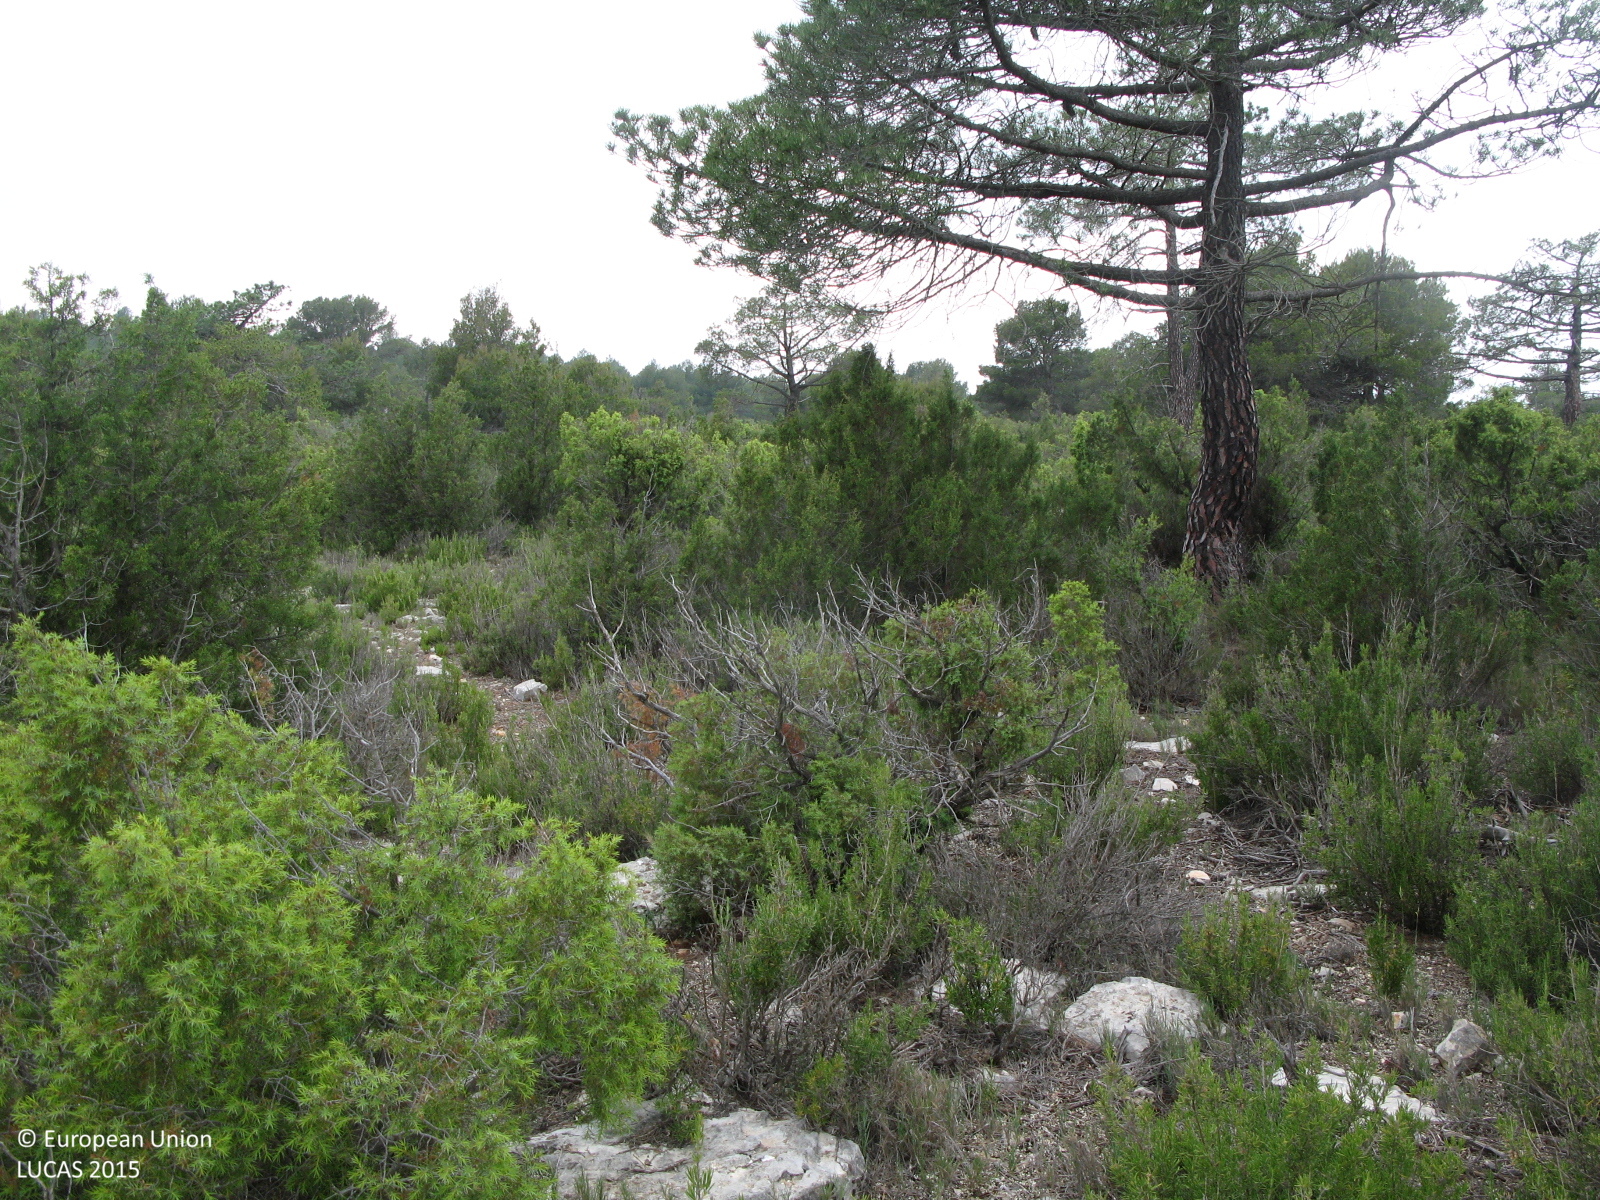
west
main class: Woodland
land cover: Pine dominated coniferous woodland
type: coniferous forest of the mediterranean region
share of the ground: 10 - 25 %
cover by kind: consolidated bare surface 40 %, shrubs 20 %, lichens and mosses 20 %, coniferous forest trees 15 %, herbaceous plants 5 %
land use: Forestry
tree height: > 5 m
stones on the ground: > 50 %
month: June
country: ES
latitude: 39.9209
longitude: -1.1563
